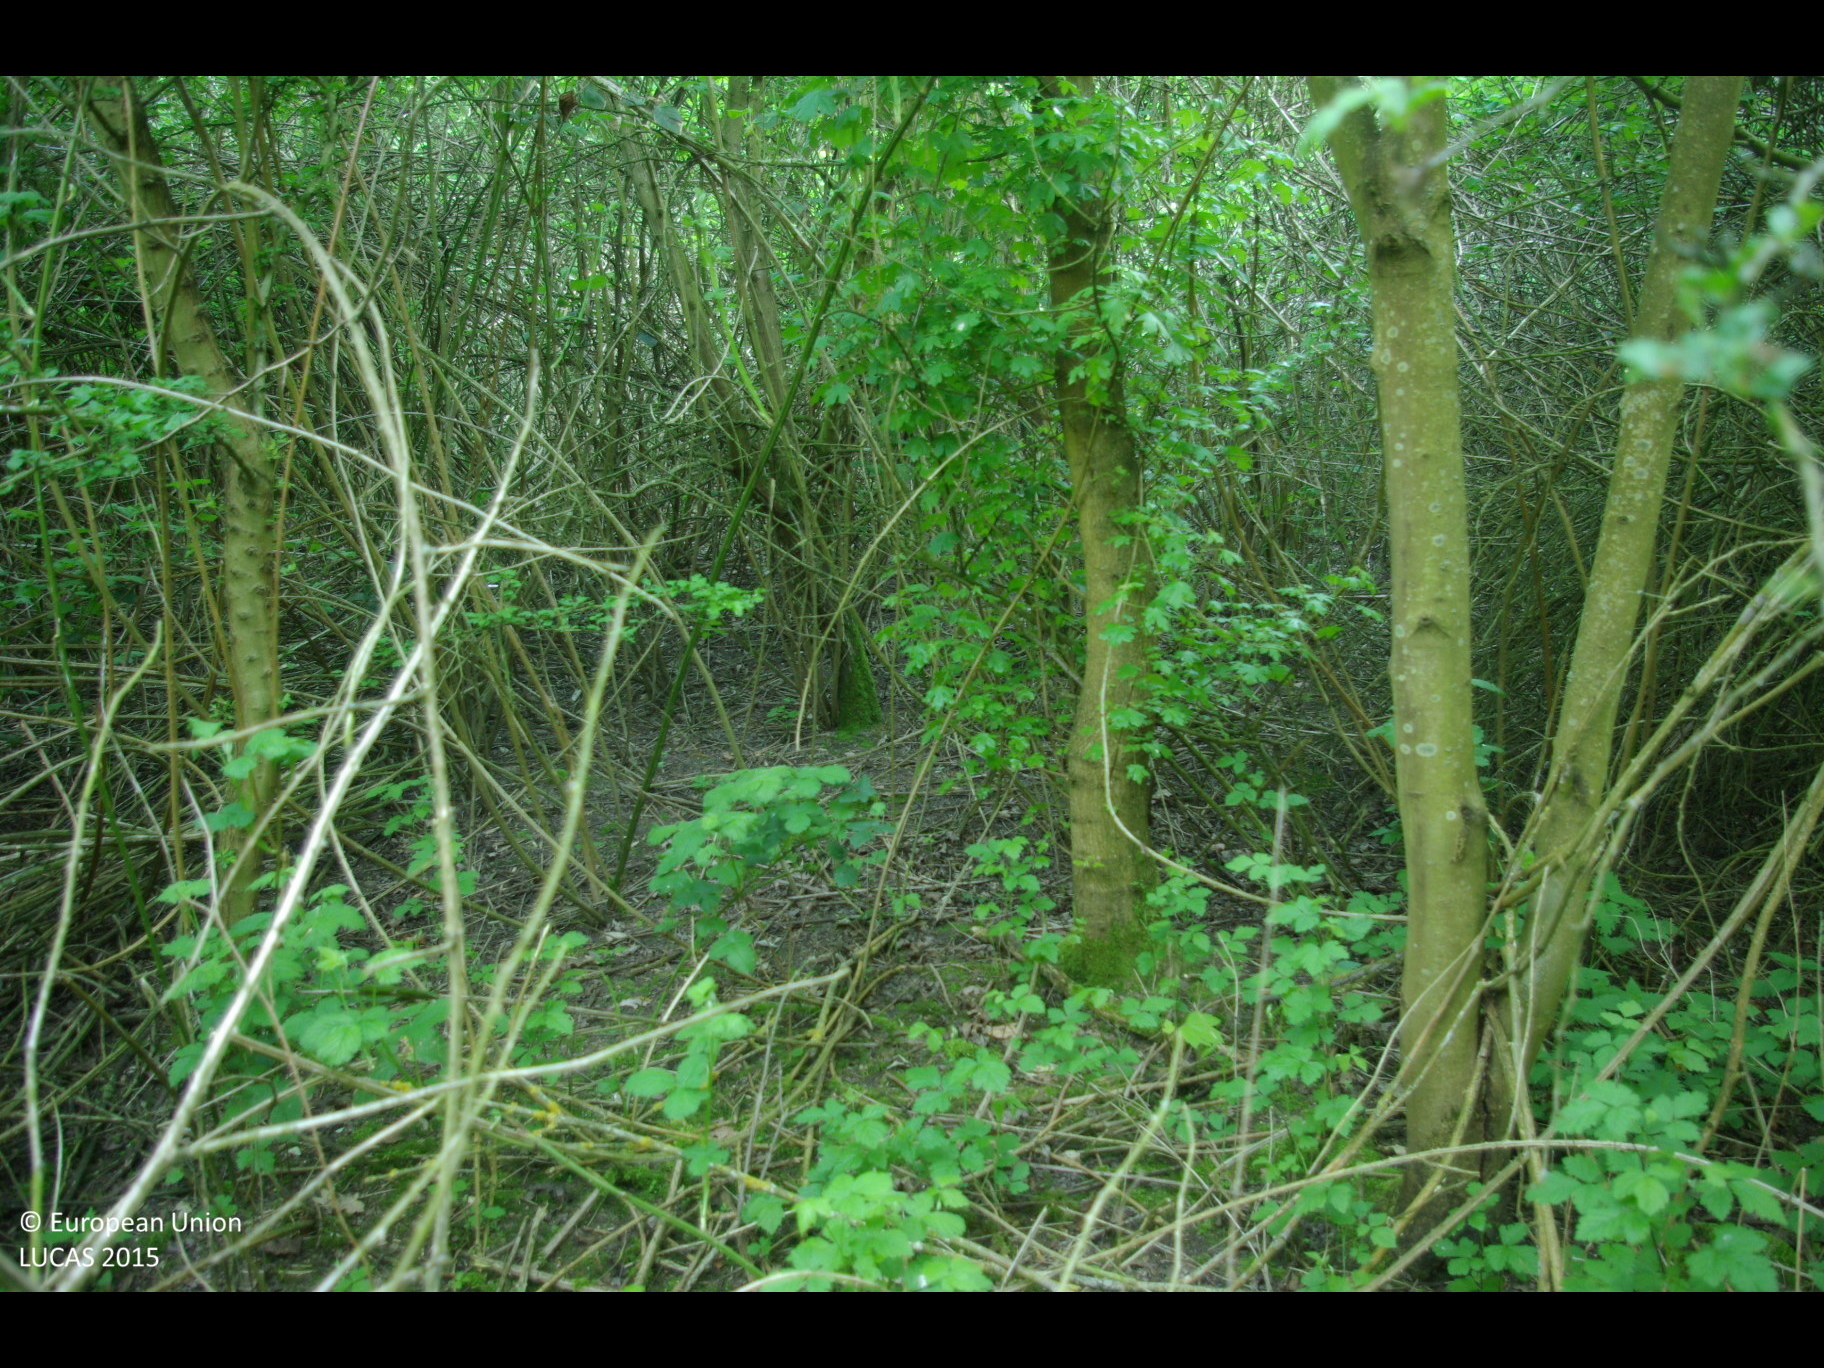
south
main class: Shrubland
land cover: Shrubland with sparse tree cover
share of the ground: > 75 %
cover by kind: shrubs 80 %, herbaceous plants 10 %, broadleaved forest trees 5 %, unconsolidated bare surface 5 %
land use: Semi-natural and natural areas not in use
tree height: < 5 m
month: May
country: DE
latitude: 54.3684
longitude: 10.9999
